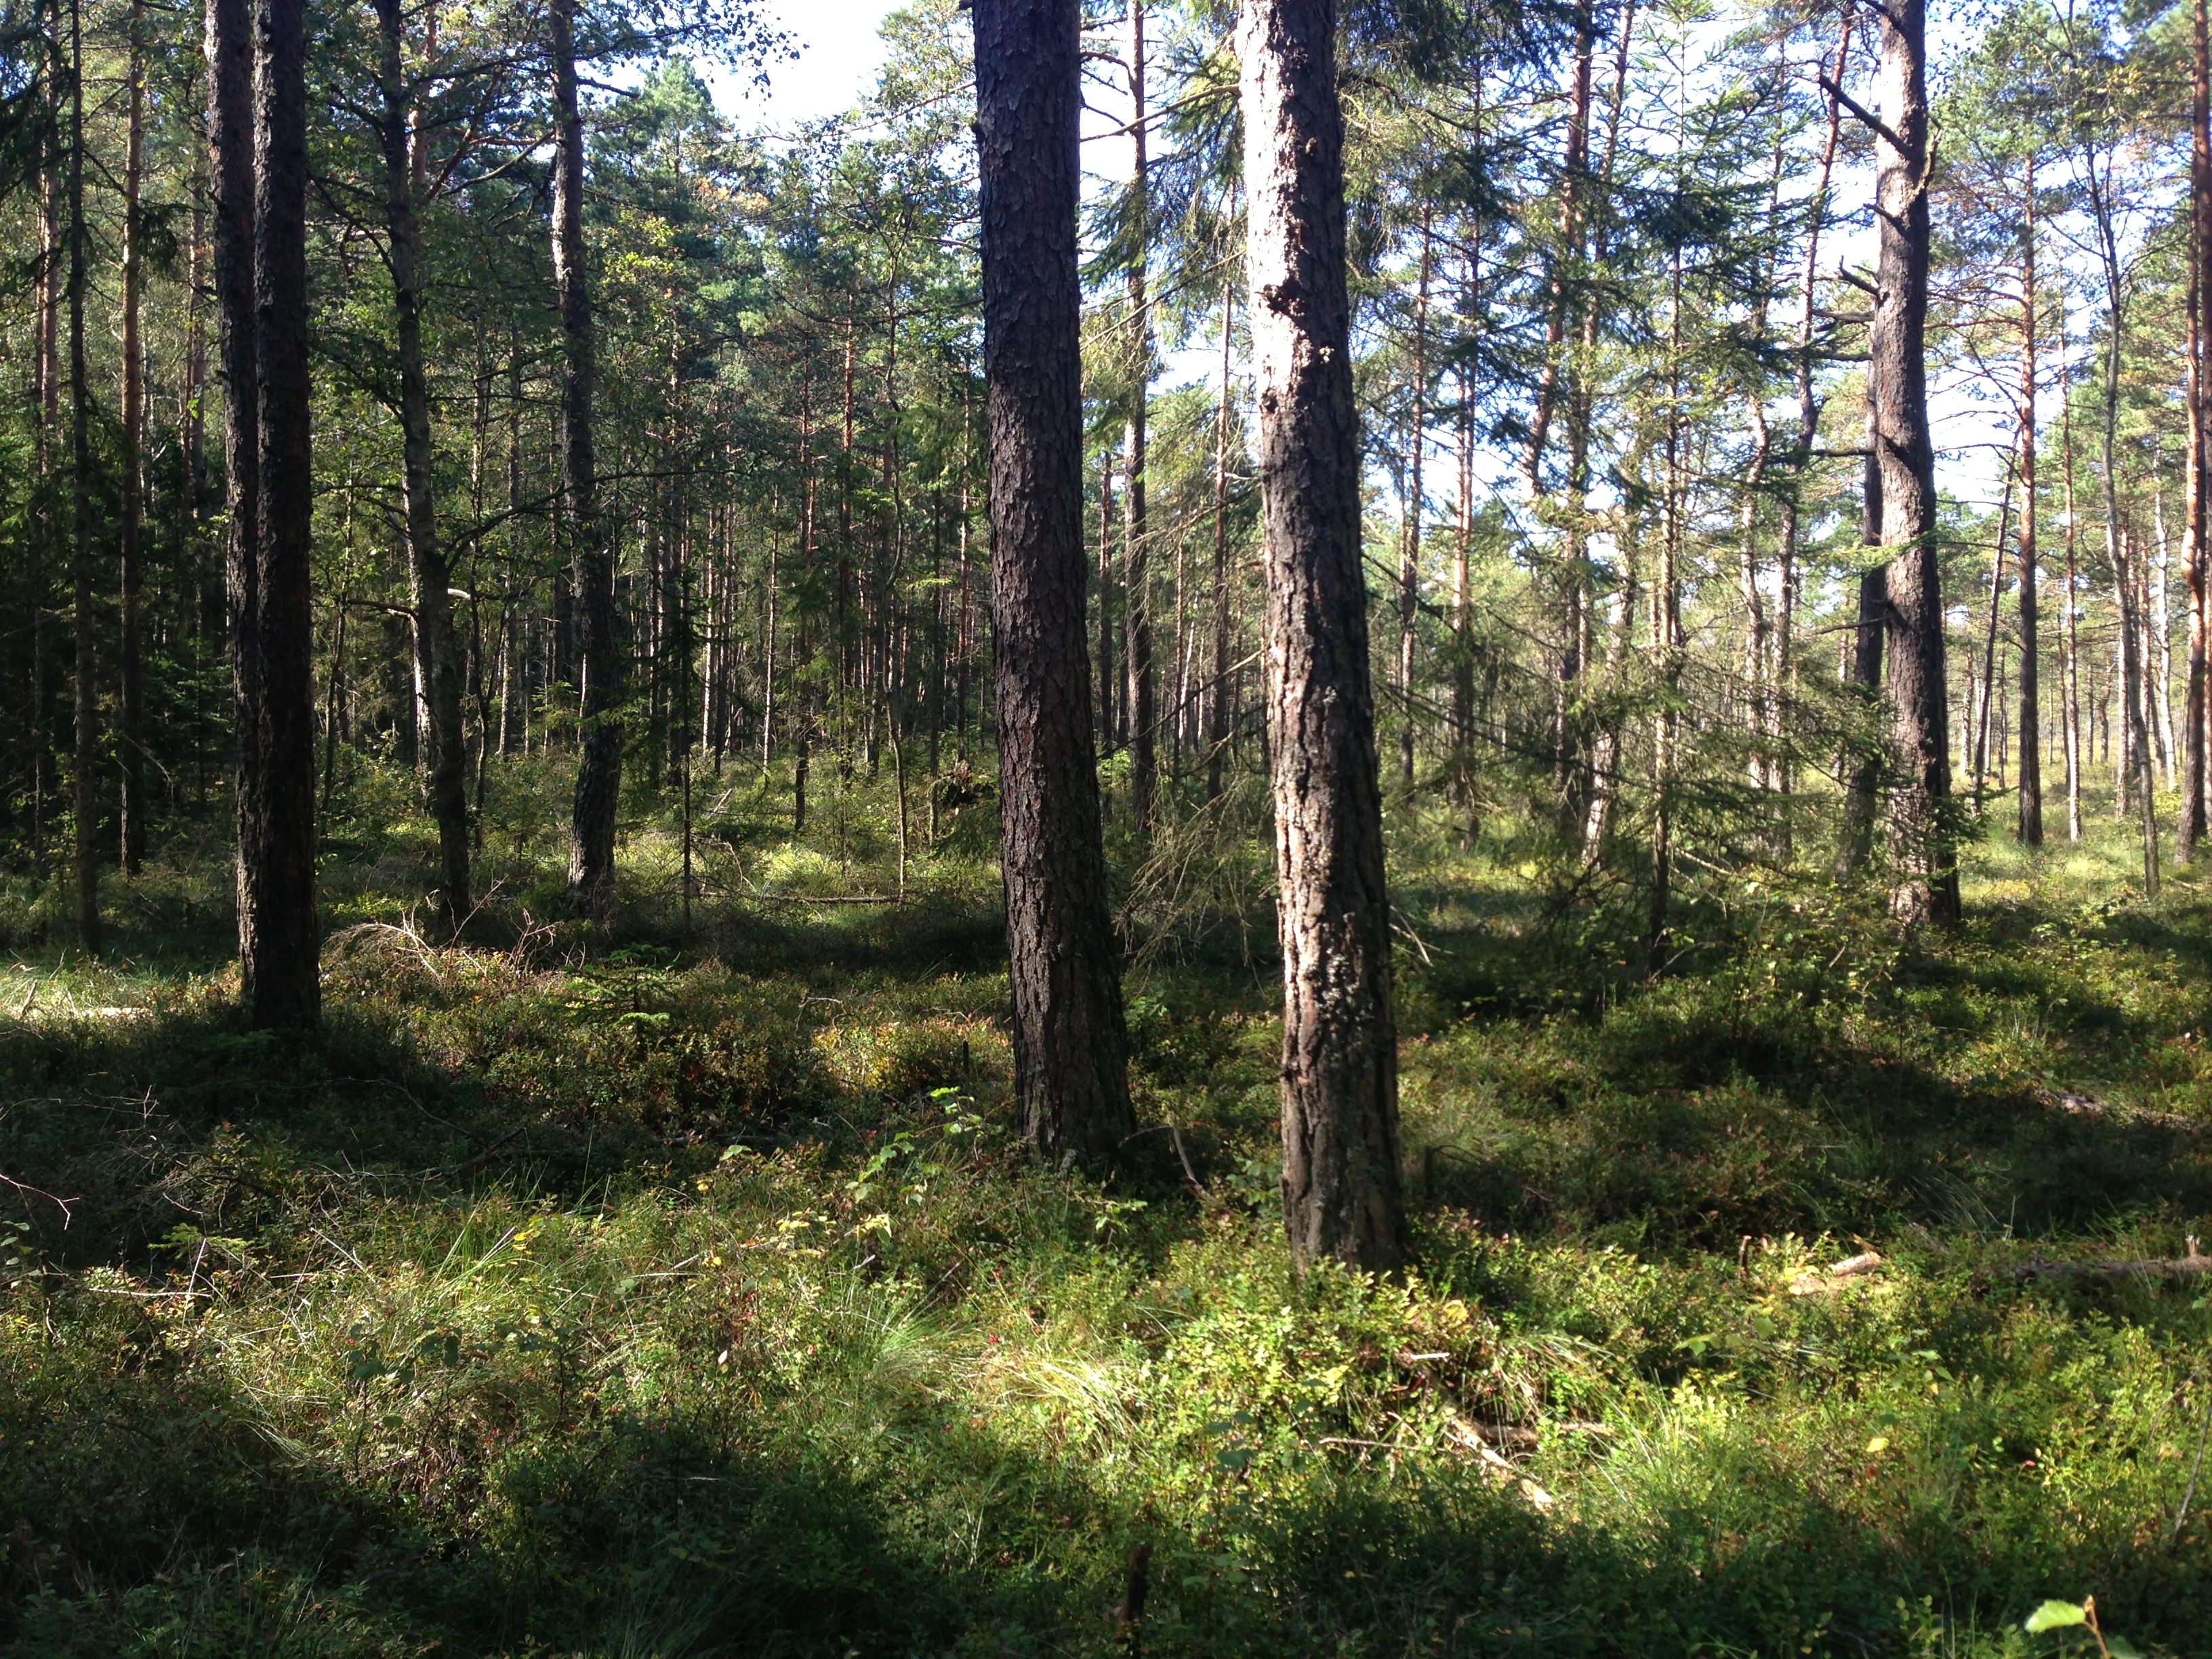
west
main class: Woodland
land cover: Pine dominated coniferous woodland
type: boreal forest
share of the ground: 50 - 75 %
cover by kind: coniferous forest trees 75 %, shrubs 25 %
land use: Forestry
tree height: > 5 m
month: September
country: SE
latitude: 57.1722
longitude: 13.2543
